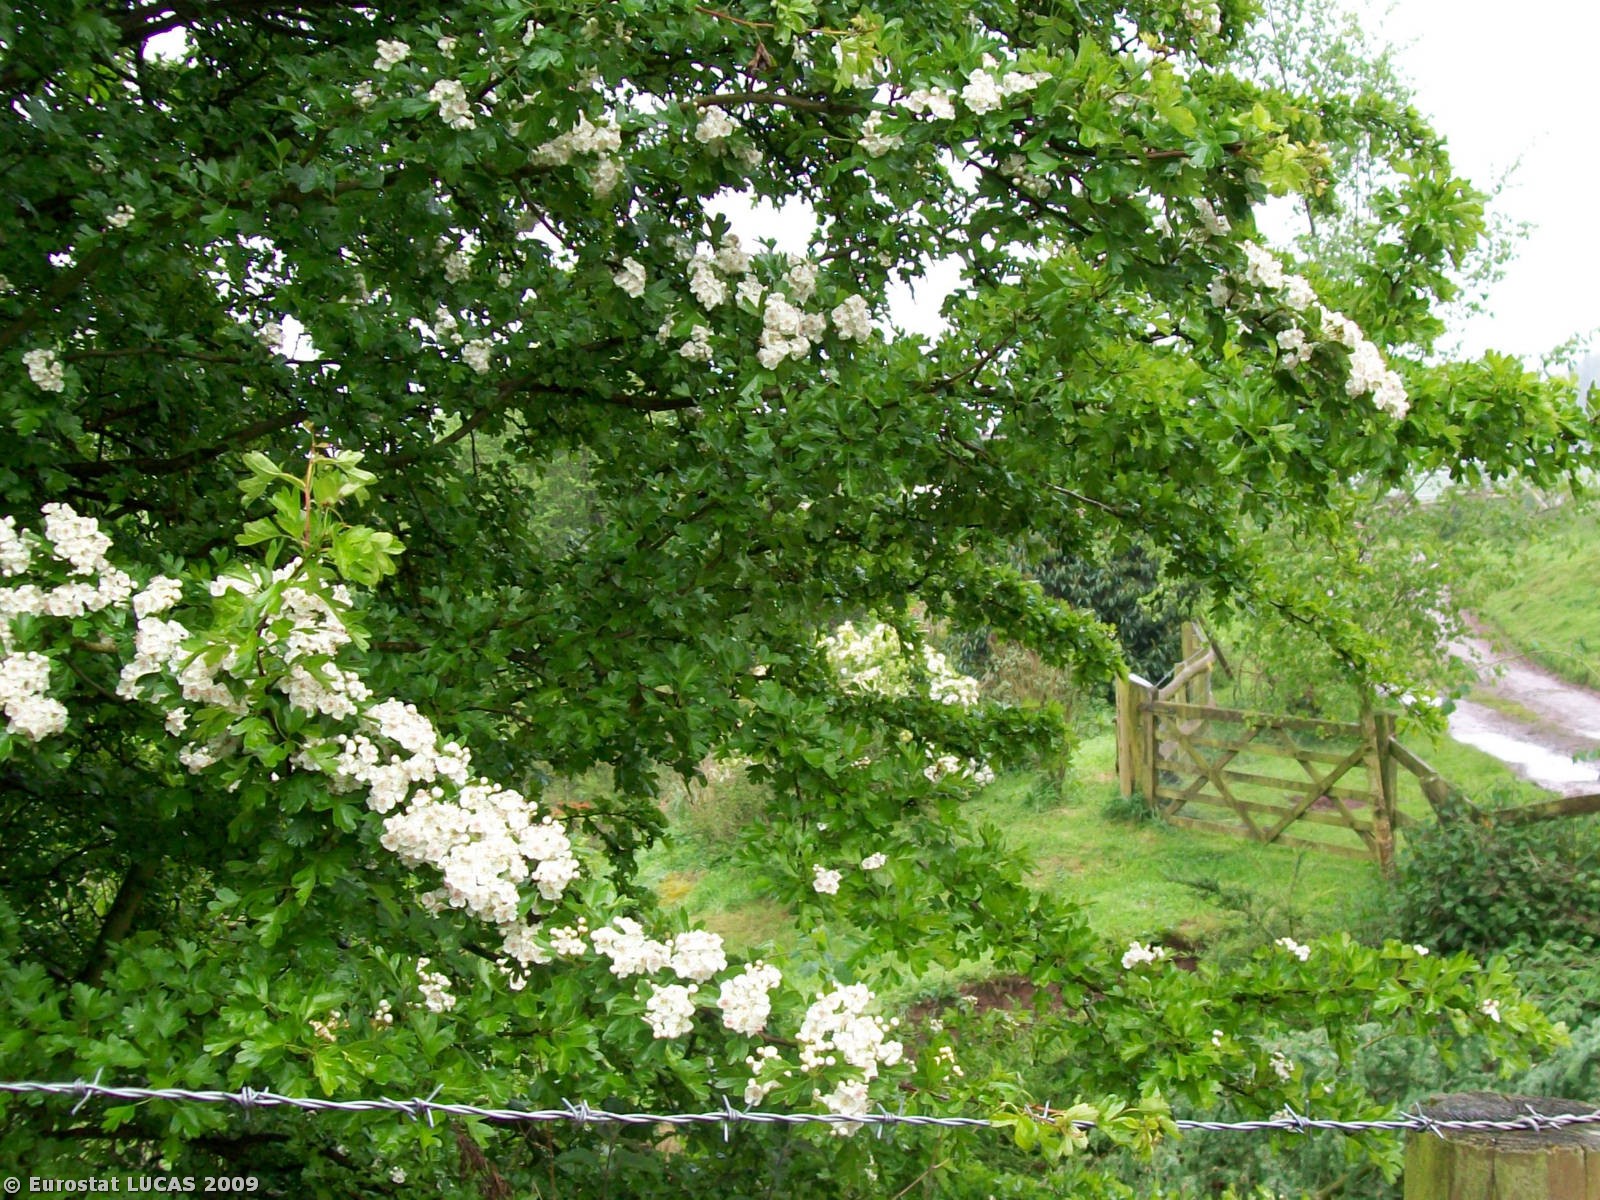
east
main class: Grassland
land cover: Grassland without tree/shrub cover
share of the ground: > 75 %
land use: Agriculture (excluding fallow land and kitchen gardens)
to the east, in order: Grassland without tree/shrub cover; Abandoned hedges; Grassland without tree/shrub cover; Abandoned hedges; Grassland without tree/shrub cover
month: May
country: GB
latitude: 52.0582
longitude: -3.0120
